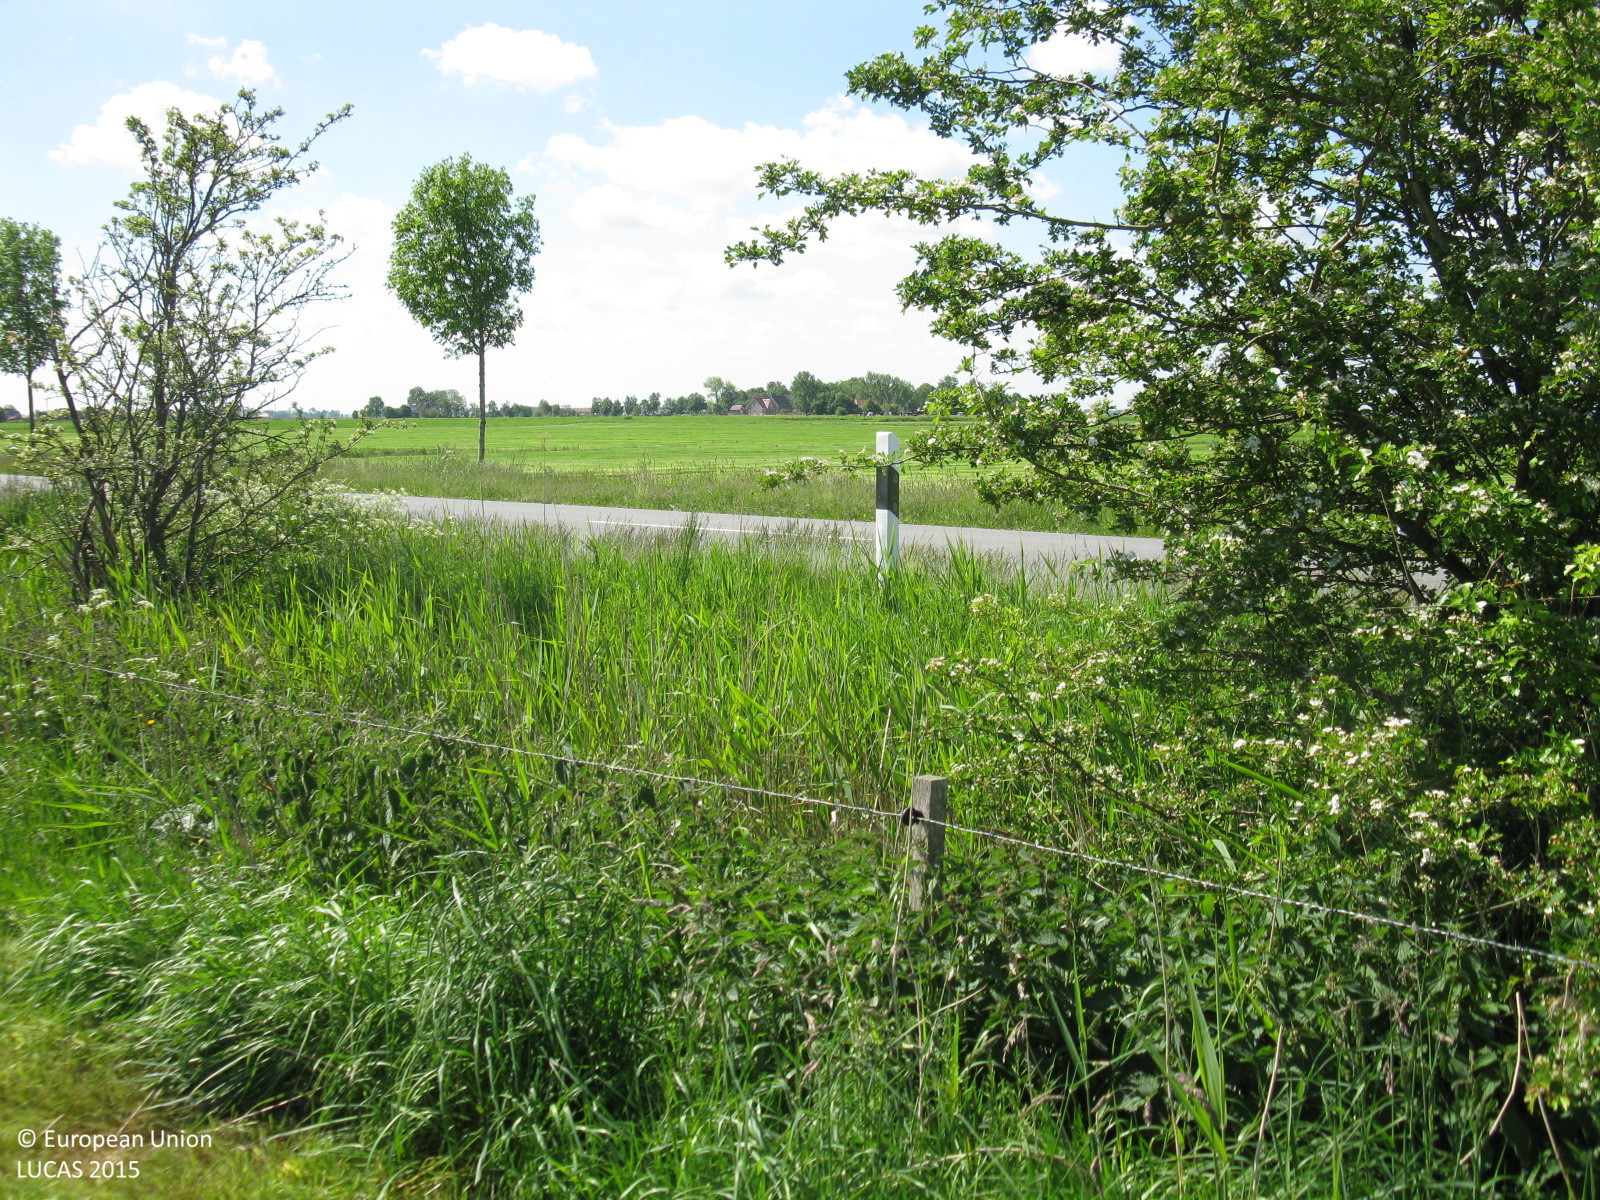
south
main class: Grassland
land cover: Grassland without tree/shrub cover
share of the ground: > 75 %
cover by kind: herbaceous plants 100 %
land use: Agriculture (excluding fallow land and kitchen gardens)
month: June
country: DE
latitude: 53.3009
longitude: 7.3447
